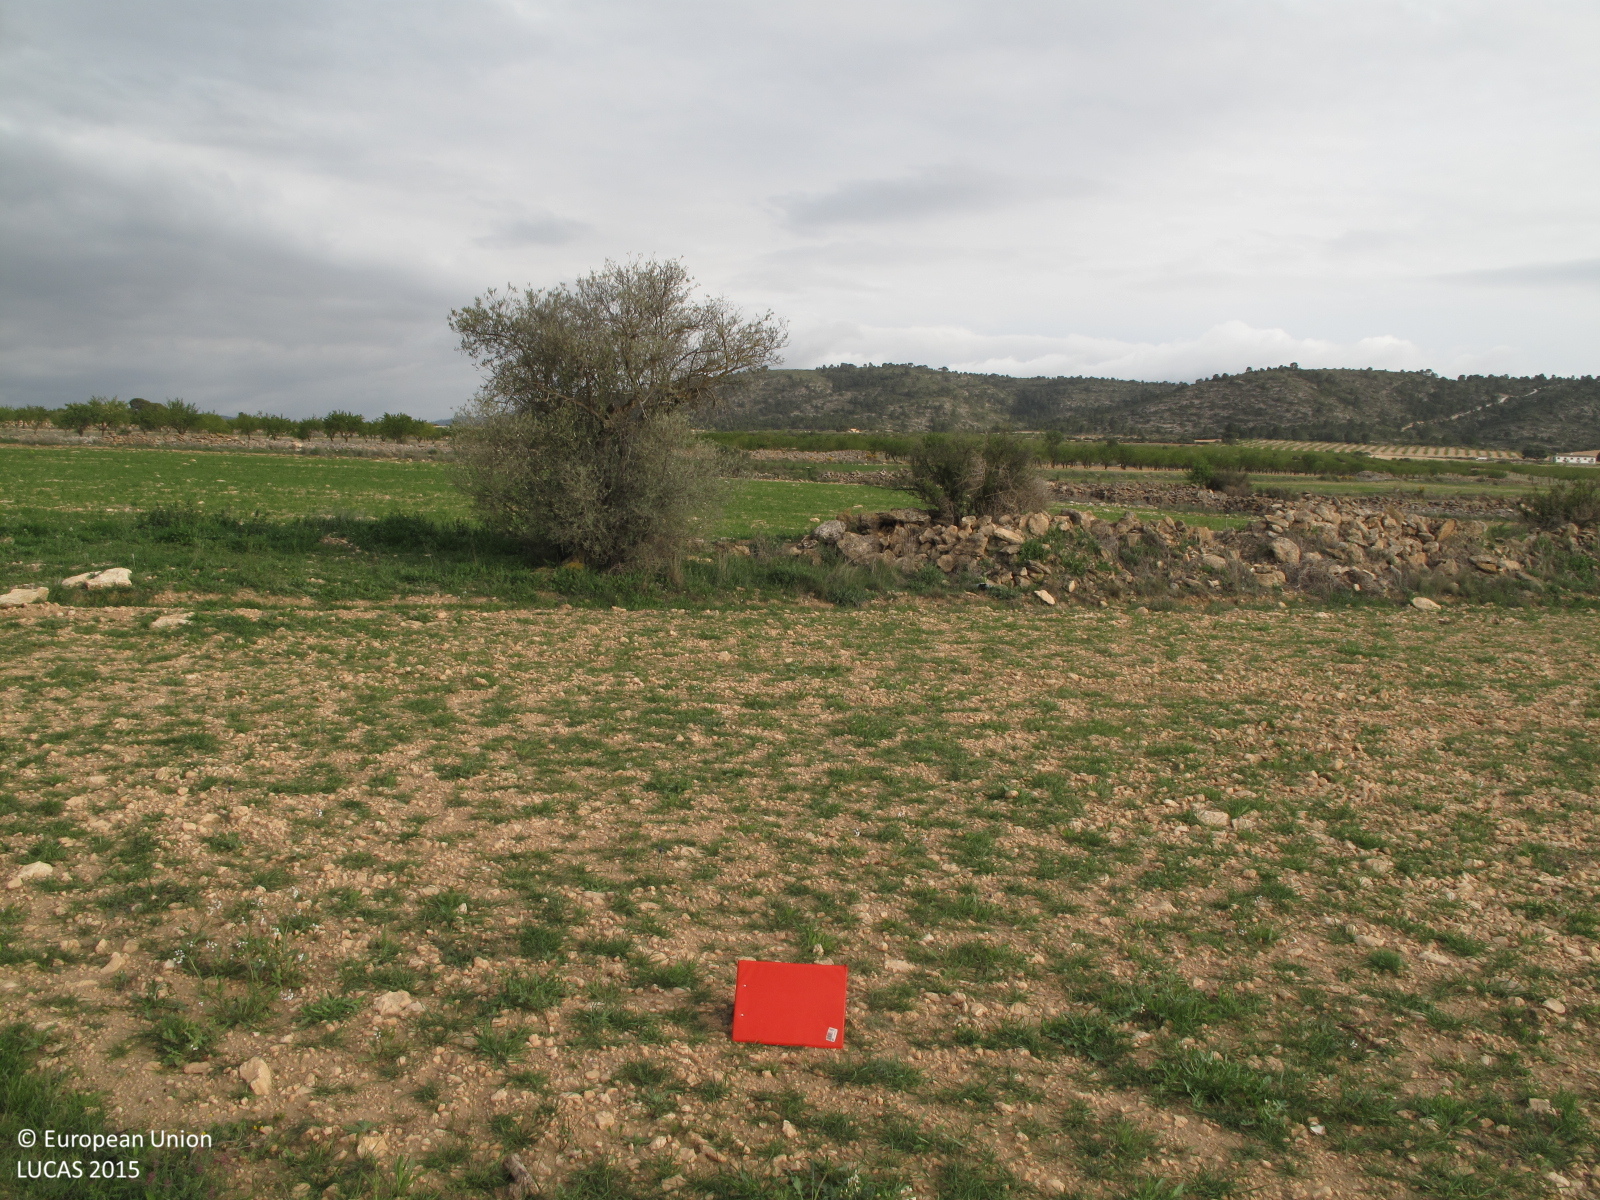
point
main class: Grassland
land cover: Spontaneously vegetated surfaces
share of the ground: 10 - 25 %
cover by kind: unconsolidated bare surface 80 %, herbaceous plants 20 %
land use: Fallow land
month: April
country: ES
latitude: 38.5880
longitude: -1.0001
